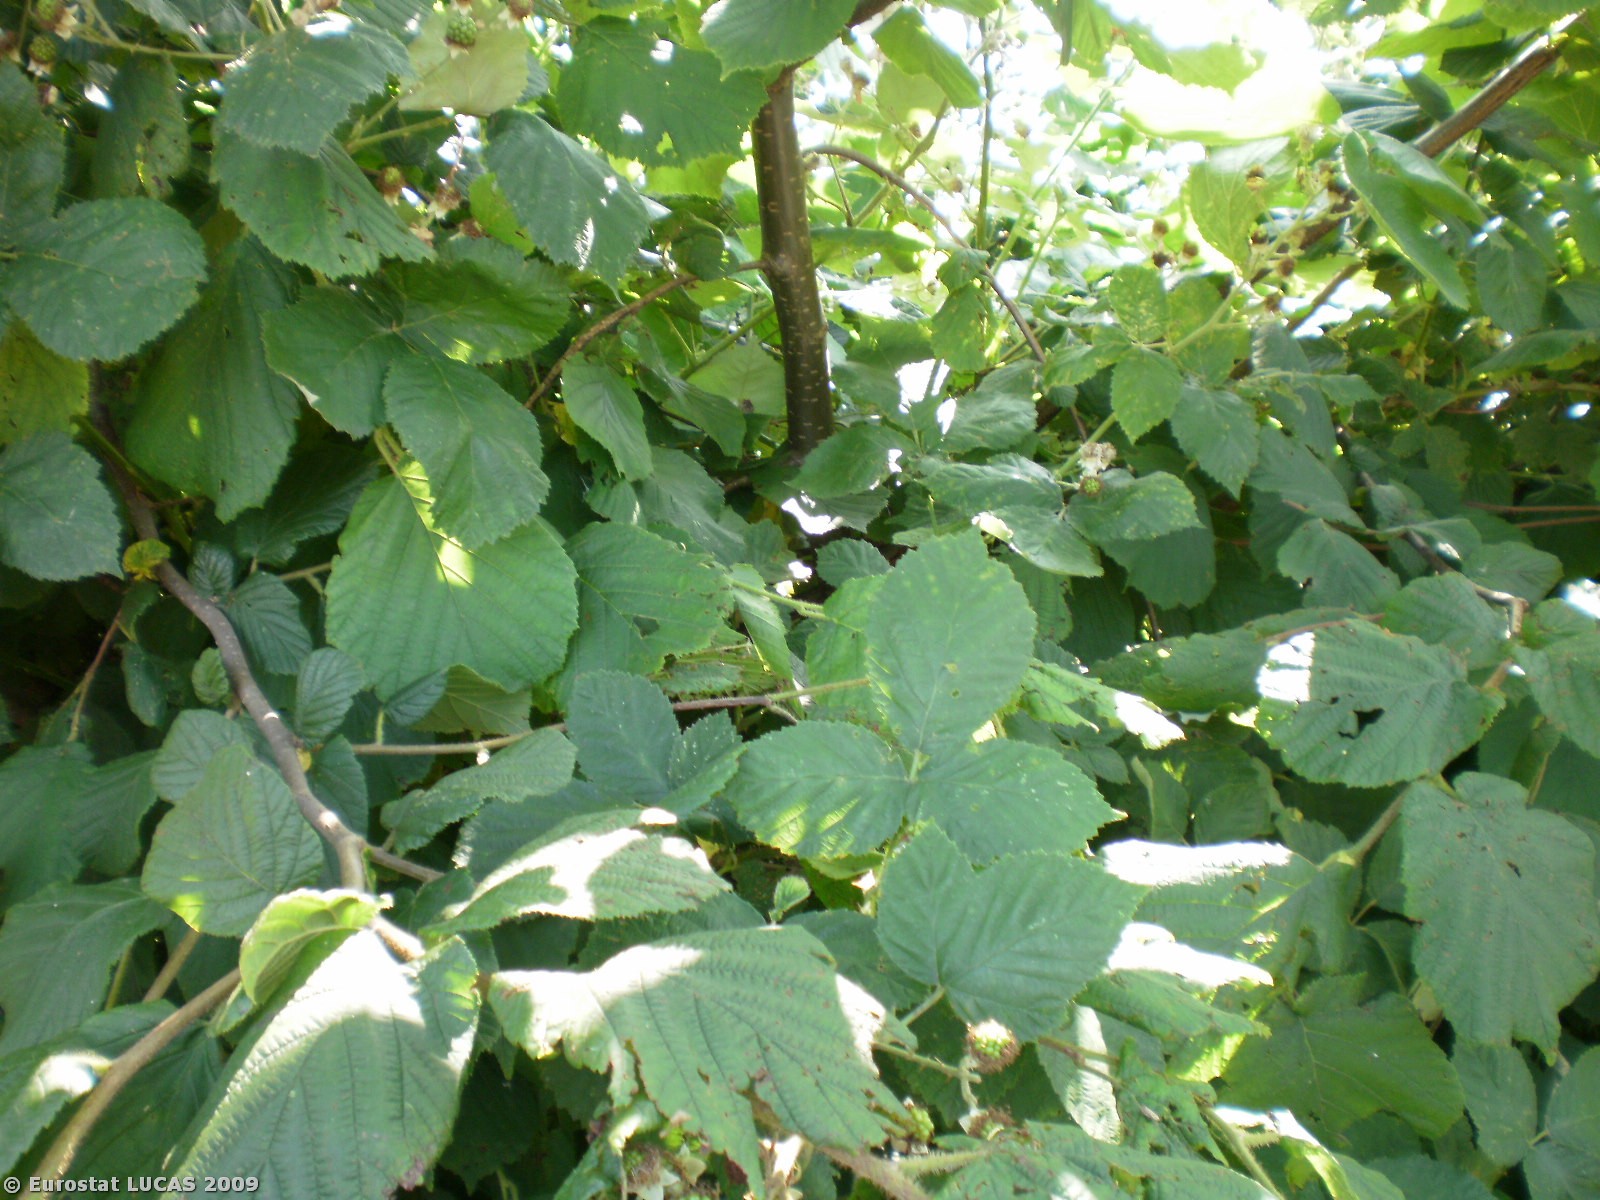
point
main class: Shrubland
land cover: Shrubland without tree cover
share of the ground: > 75 %
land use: Unused
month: June
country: BE
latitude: 50.5952
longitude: 3.8485
